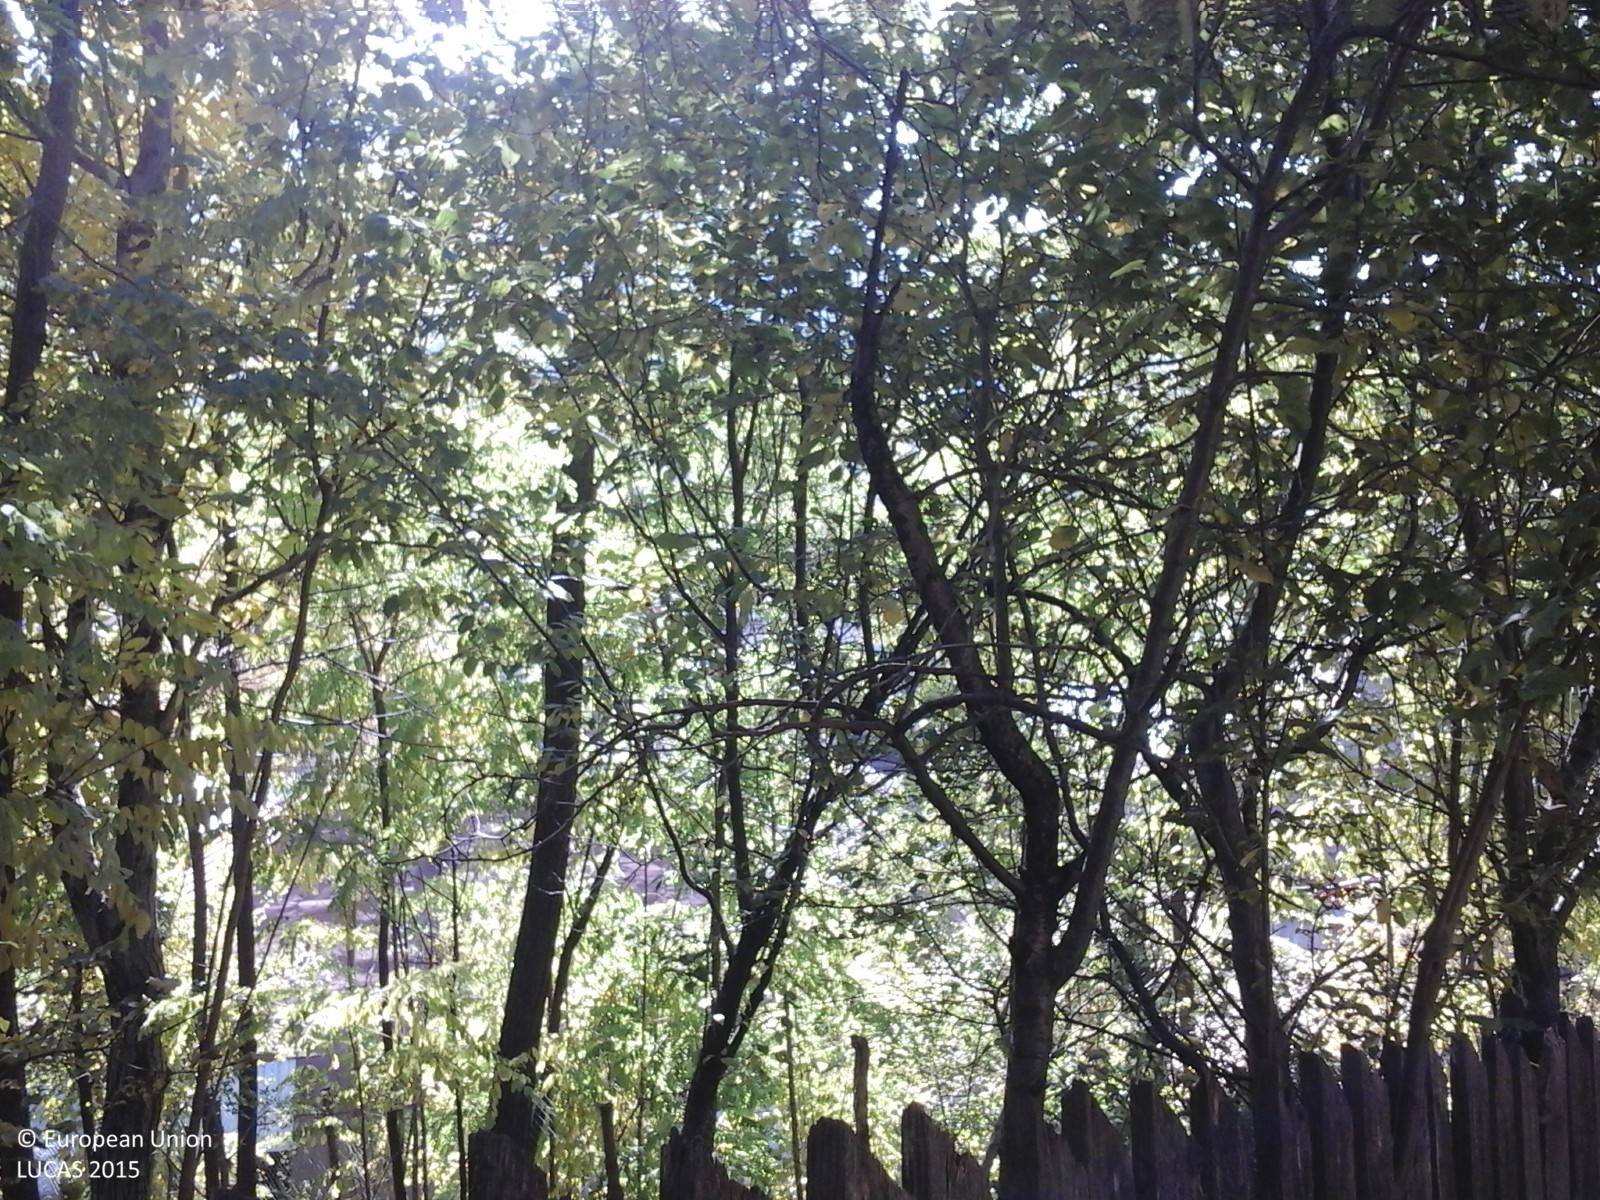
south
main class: Woodland
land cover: Broadleaved woodland
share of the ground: > 75 %
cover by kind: broadleaved forest trees 100 %
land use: Forestry
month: October
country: RO
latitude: 45.4844
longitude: 26.5939
